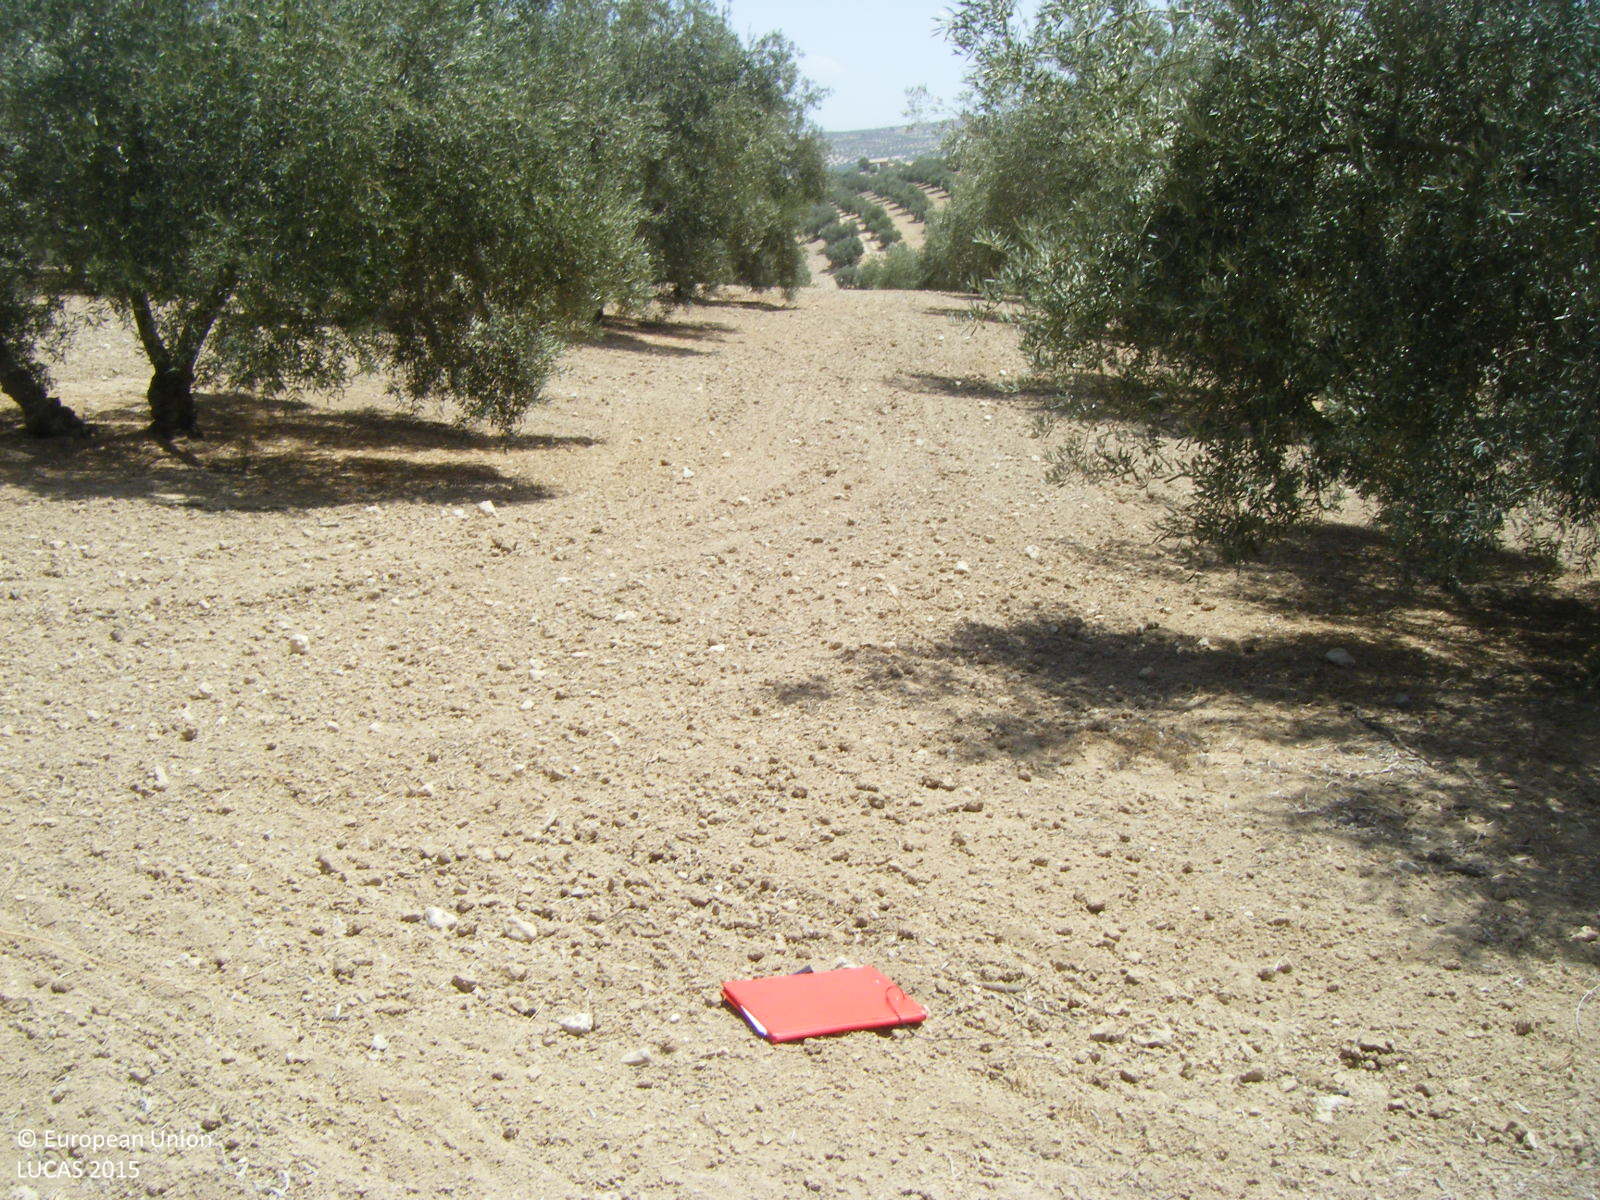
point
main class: Cropland
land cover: Olive groves
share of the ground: 25 - 50 %
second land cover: Other bare soil
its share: > 75 %
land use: Agriculture (excluding fallow land and kitchen gardens)
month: August
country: ES
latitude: 37.1360
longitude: -4.0759
